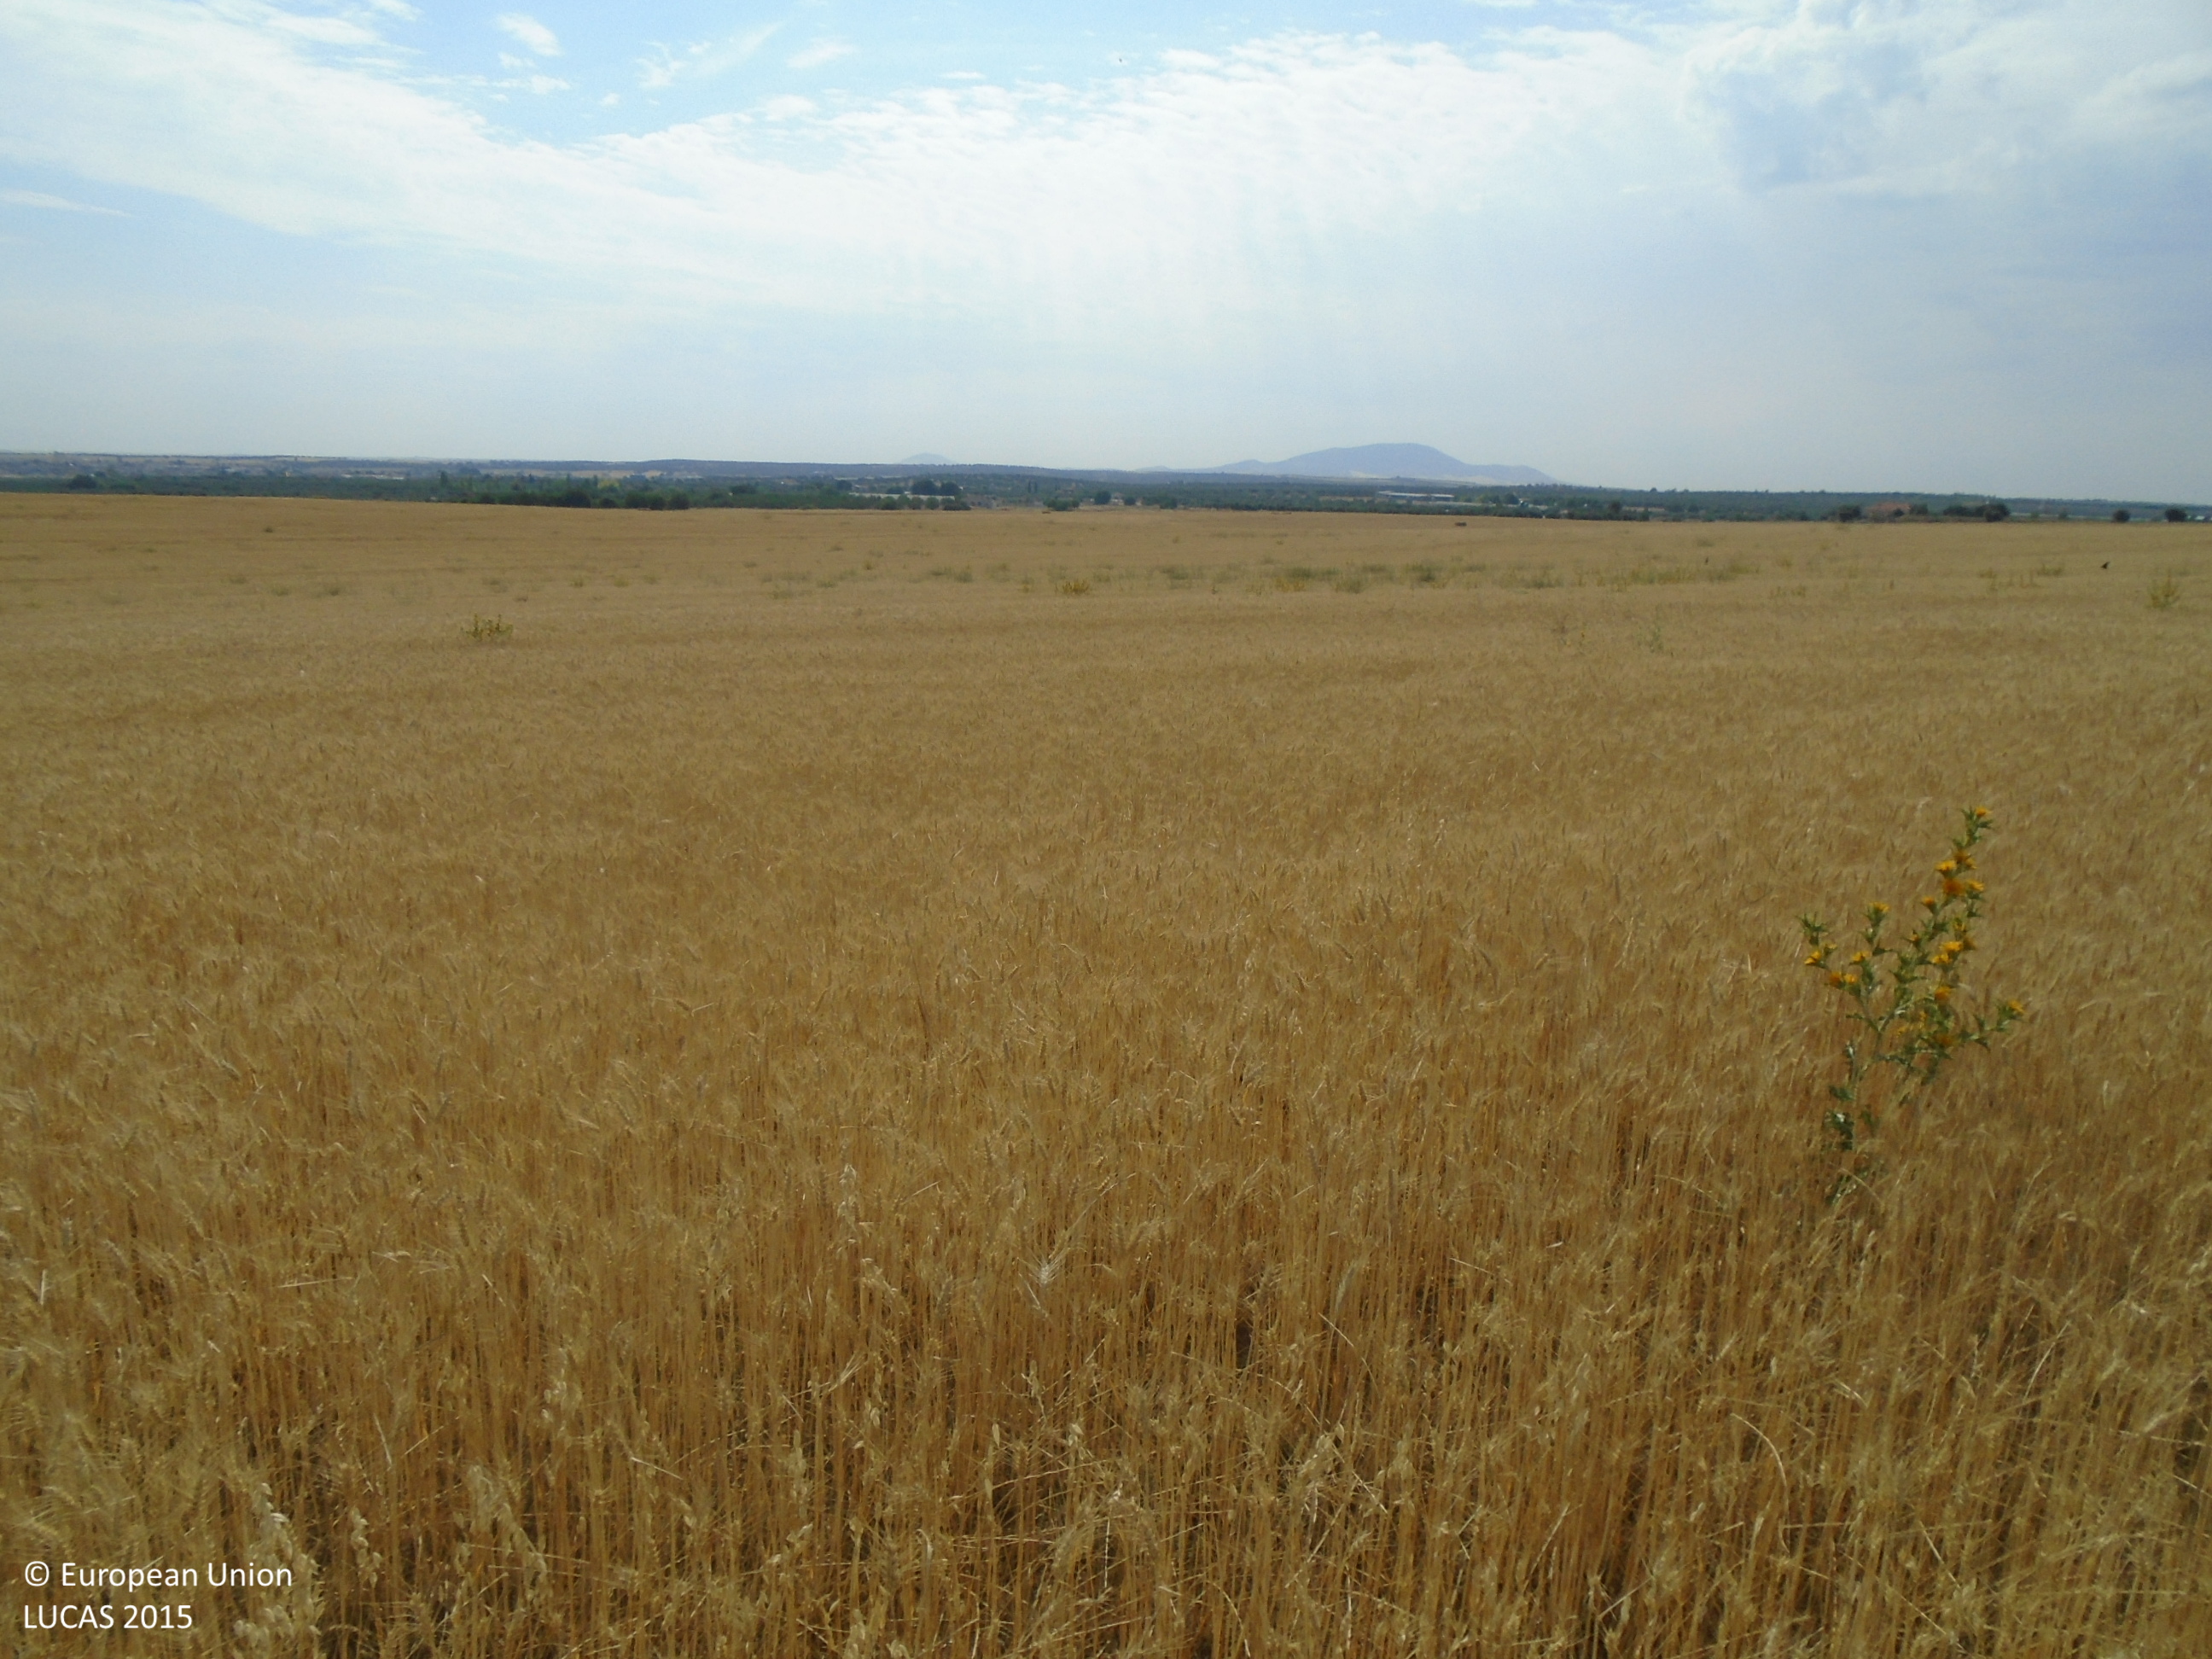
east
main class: Cropland
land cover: Common wheat
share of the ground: > 75 %
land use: Agriculture (excluding fallow land and kitchen gardens)
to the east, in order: Common wheat
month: June
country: ES
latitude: 39.7791
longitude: -4.1983
